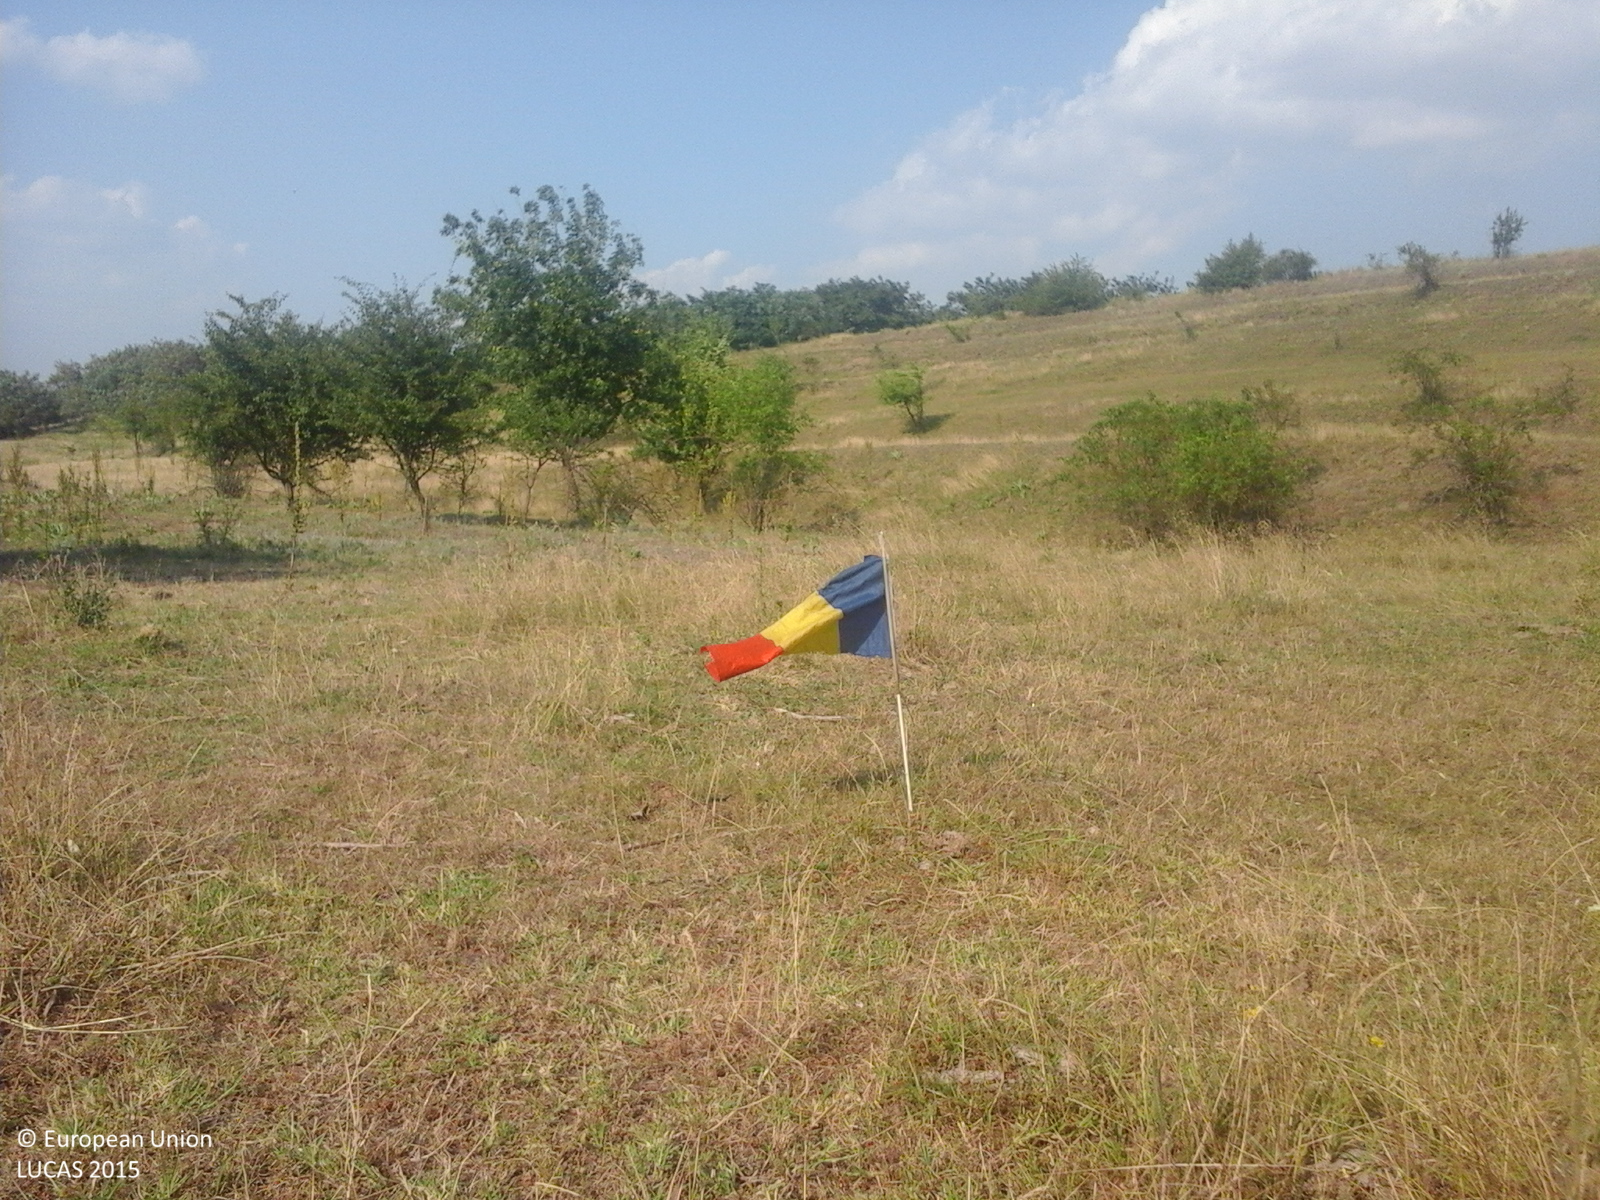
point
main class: Grassland
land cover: Grassland with sparse tree/shrub cover
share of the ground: > 75 %
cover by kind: herbaceous plants 95 %, broadleaved forest trees 5 %
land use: Agriculture (excluding fallow land and kitchen gardens)
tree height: > 5 m
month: July
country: RO
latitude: 46.1002
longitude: 27.7733
